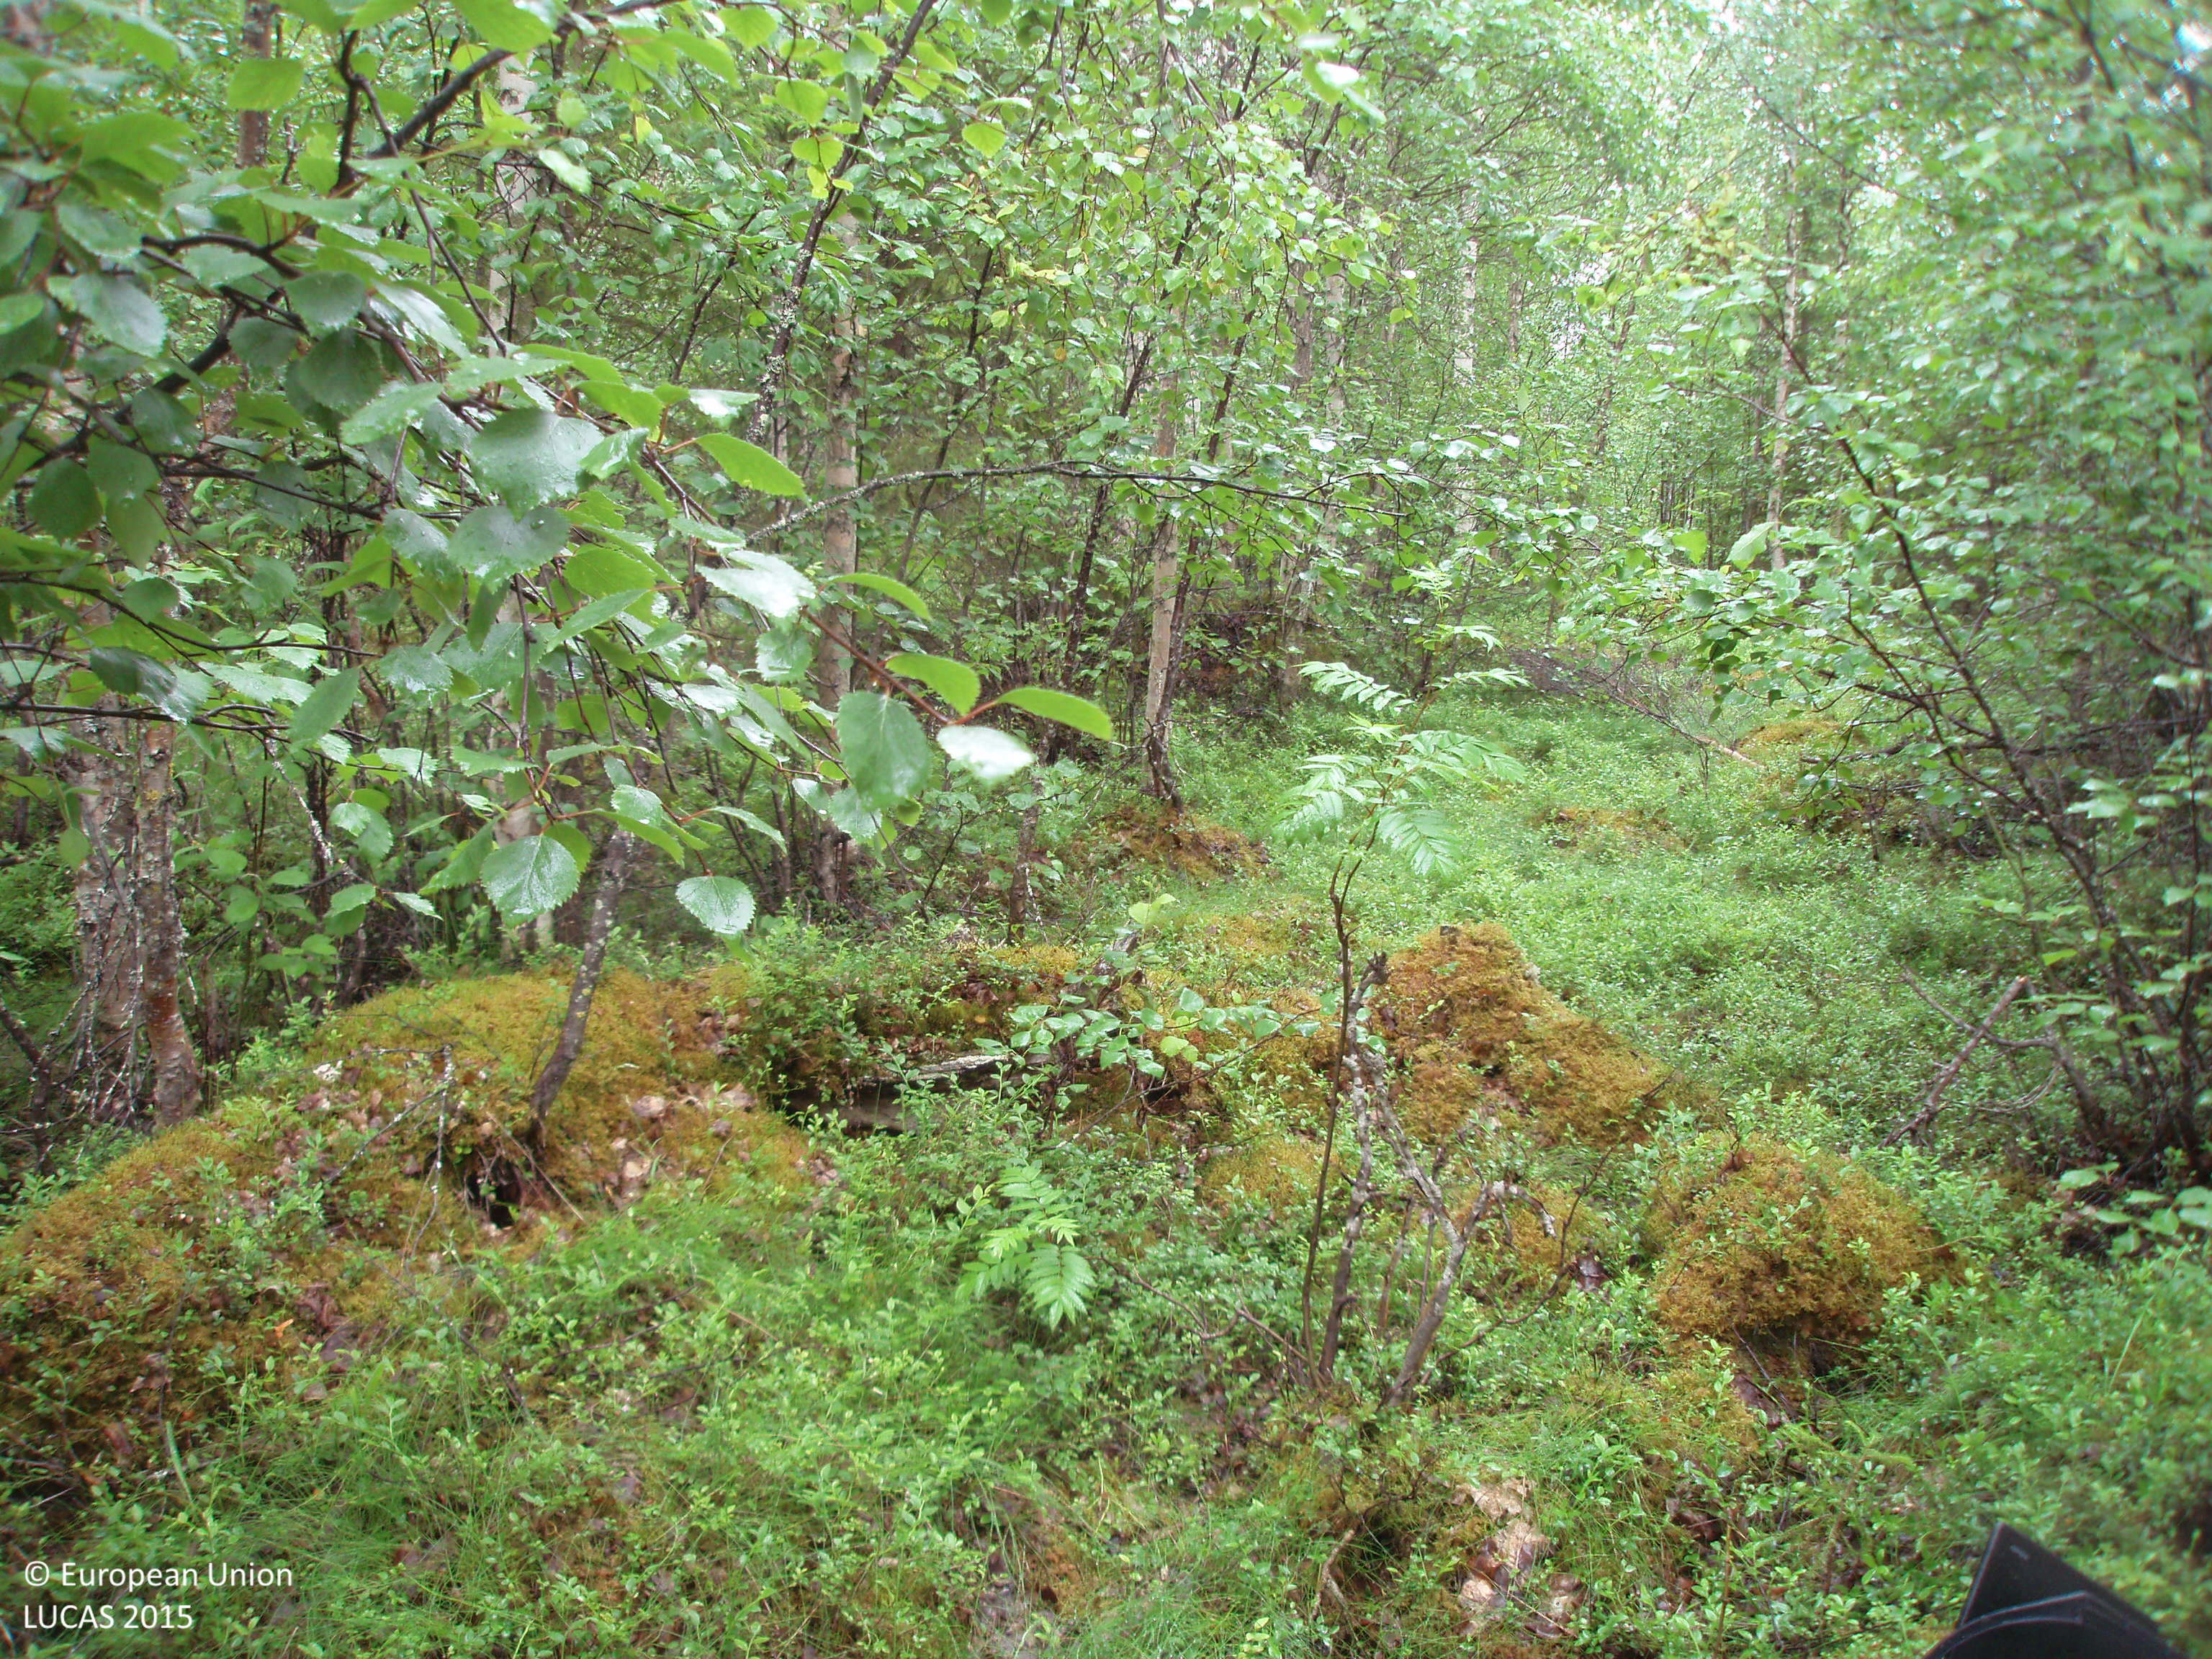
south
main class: Woodland
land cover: Broadleaved woodland
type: boreal forest
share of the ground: > 75 %
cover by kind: broadleaved forest trees 85 %, shrubs 10 %, coniferous forest trees 5 %
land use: Forestry
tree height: > 5 m
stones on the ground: < 10 %
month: July
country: FI
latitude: 66.7039
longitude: 28.2854
